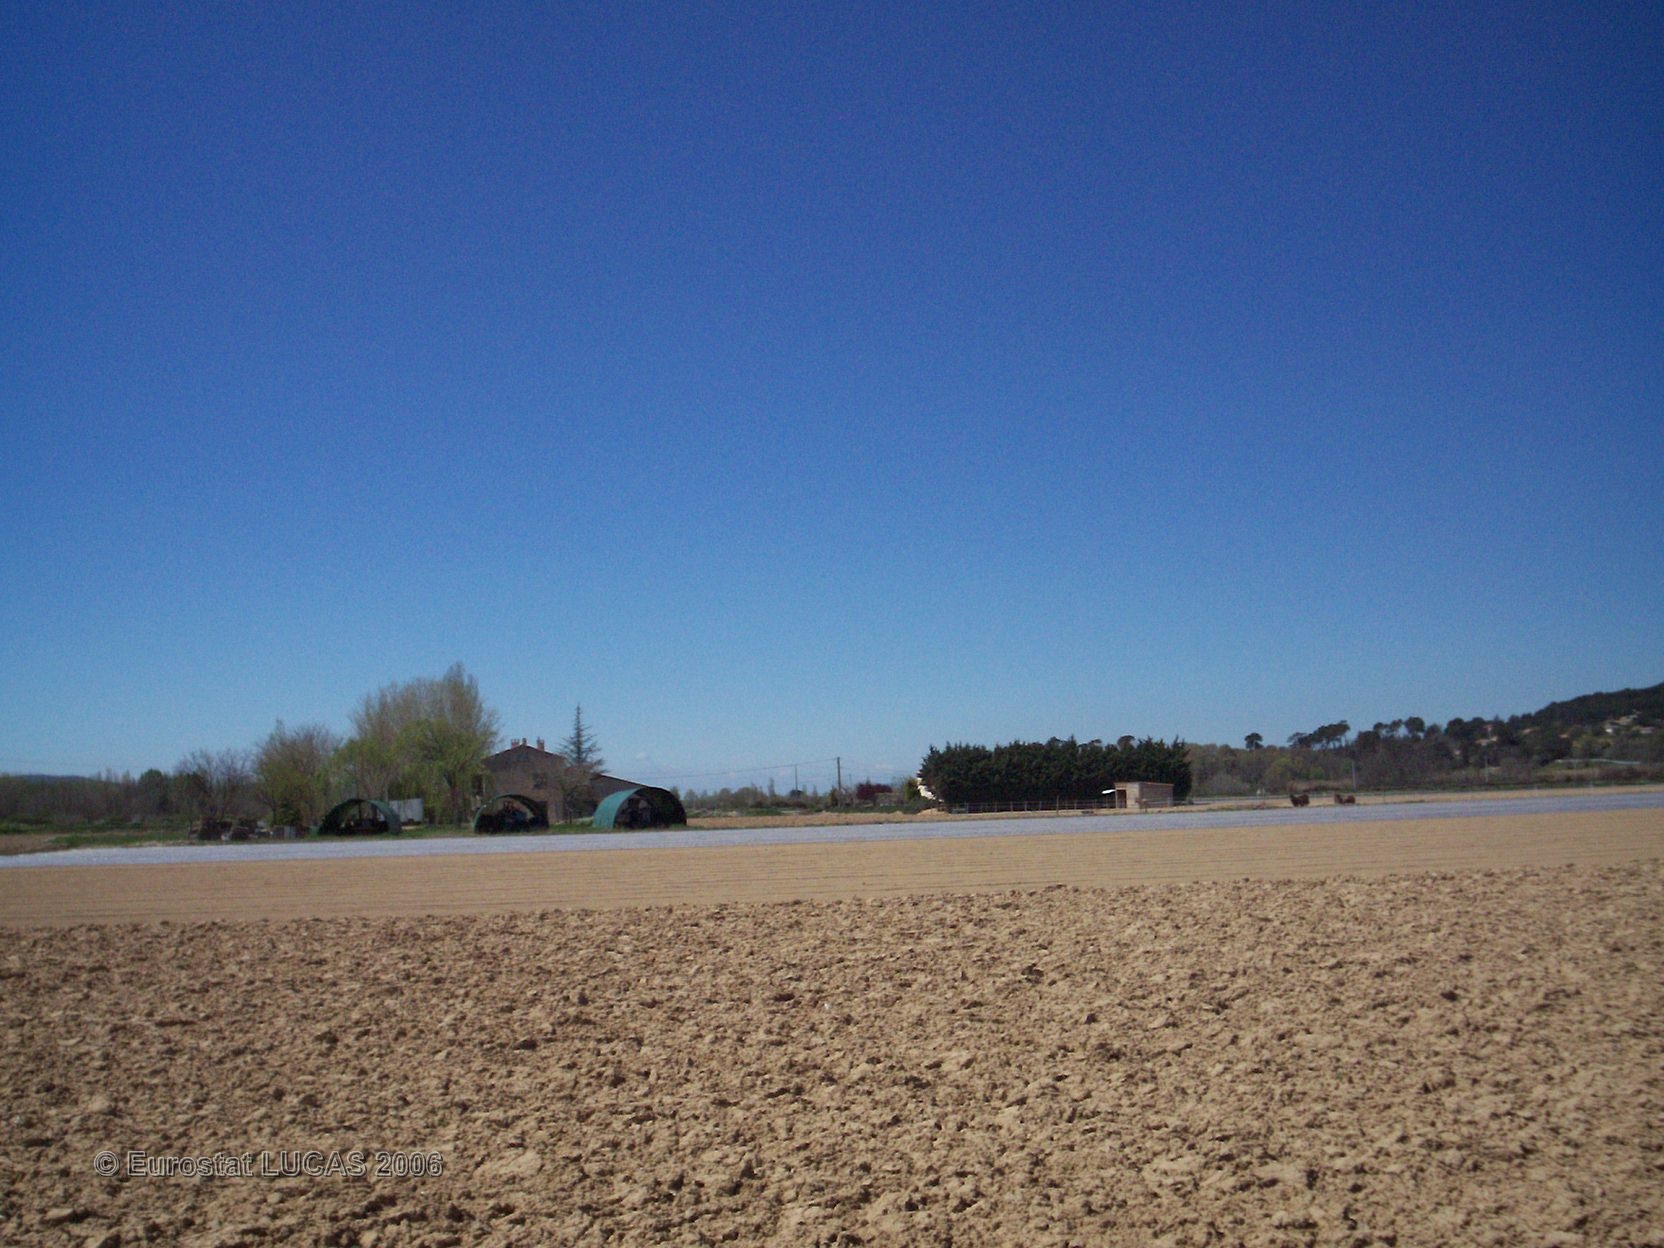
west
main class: Cropland
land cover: Maize
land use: Agriculture (excluding fallow land and kitchen gardens)
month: June
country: FR
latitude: 43.6762
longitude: 5.5315
